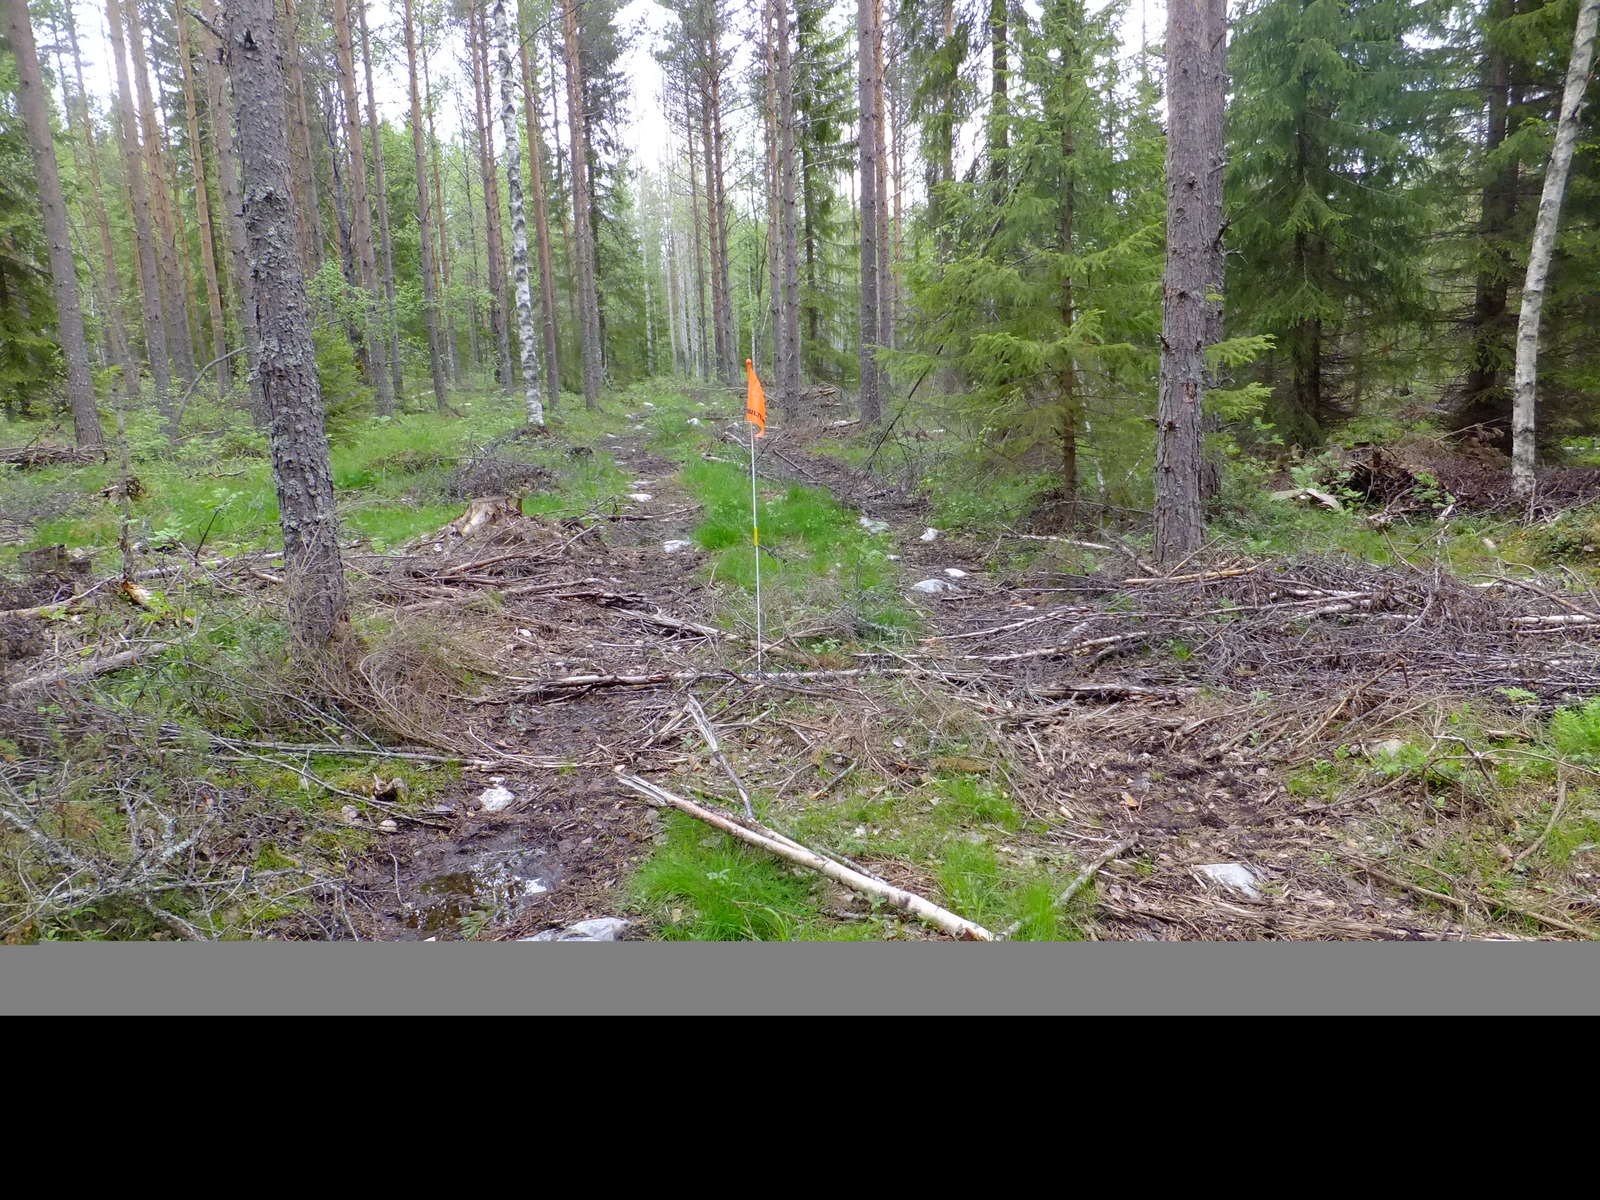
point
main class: Woodland
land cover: Pine dominated mixed woodland
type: boreal forest
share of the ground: > 75 %
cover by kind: coniferous forest trees 50 %, broadleaved forest trees 25 %, herbaceous plants 10 %, lichens and mosses 10 %, shrubs 5 %
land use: Forestry
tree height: > 5 m
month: June
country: FI
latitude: 63.4234
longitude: 23.1800
